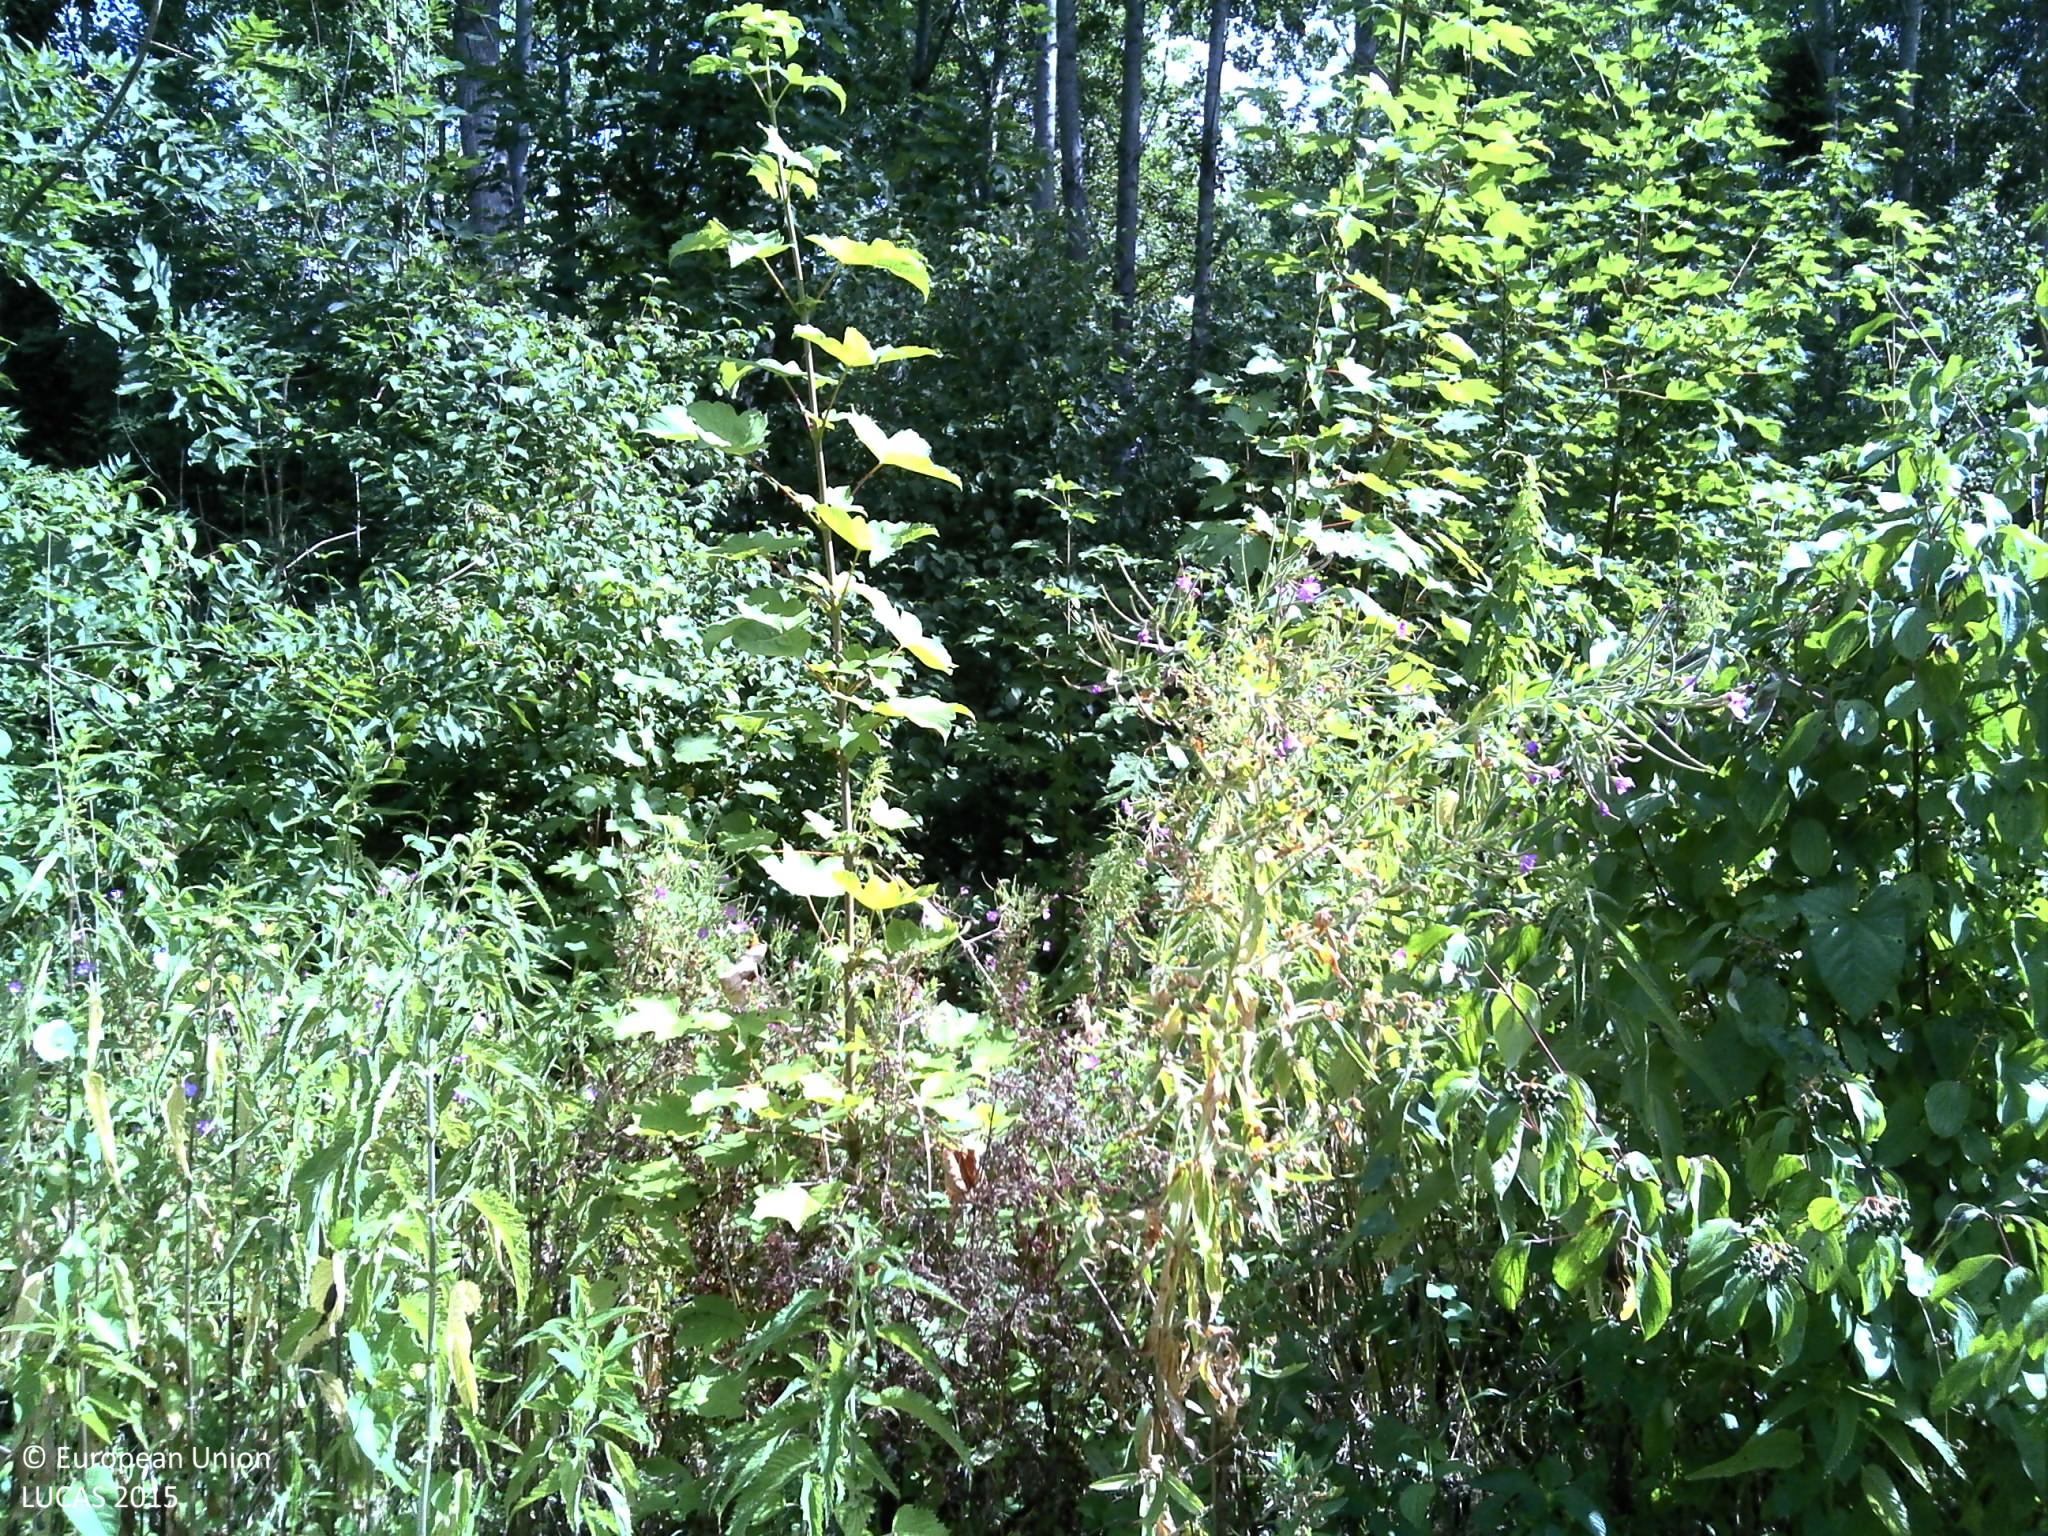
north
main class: Woodland
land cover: Broadleaved woodland
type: beech forest
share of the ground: > 75 %
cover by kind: broadleaved forest trees 80 %, herbaceous plants 20 %
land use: Forestry
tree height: > 5 m
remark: Clear cut
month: July
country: FR
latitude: 48.7622
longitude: 4.6782
